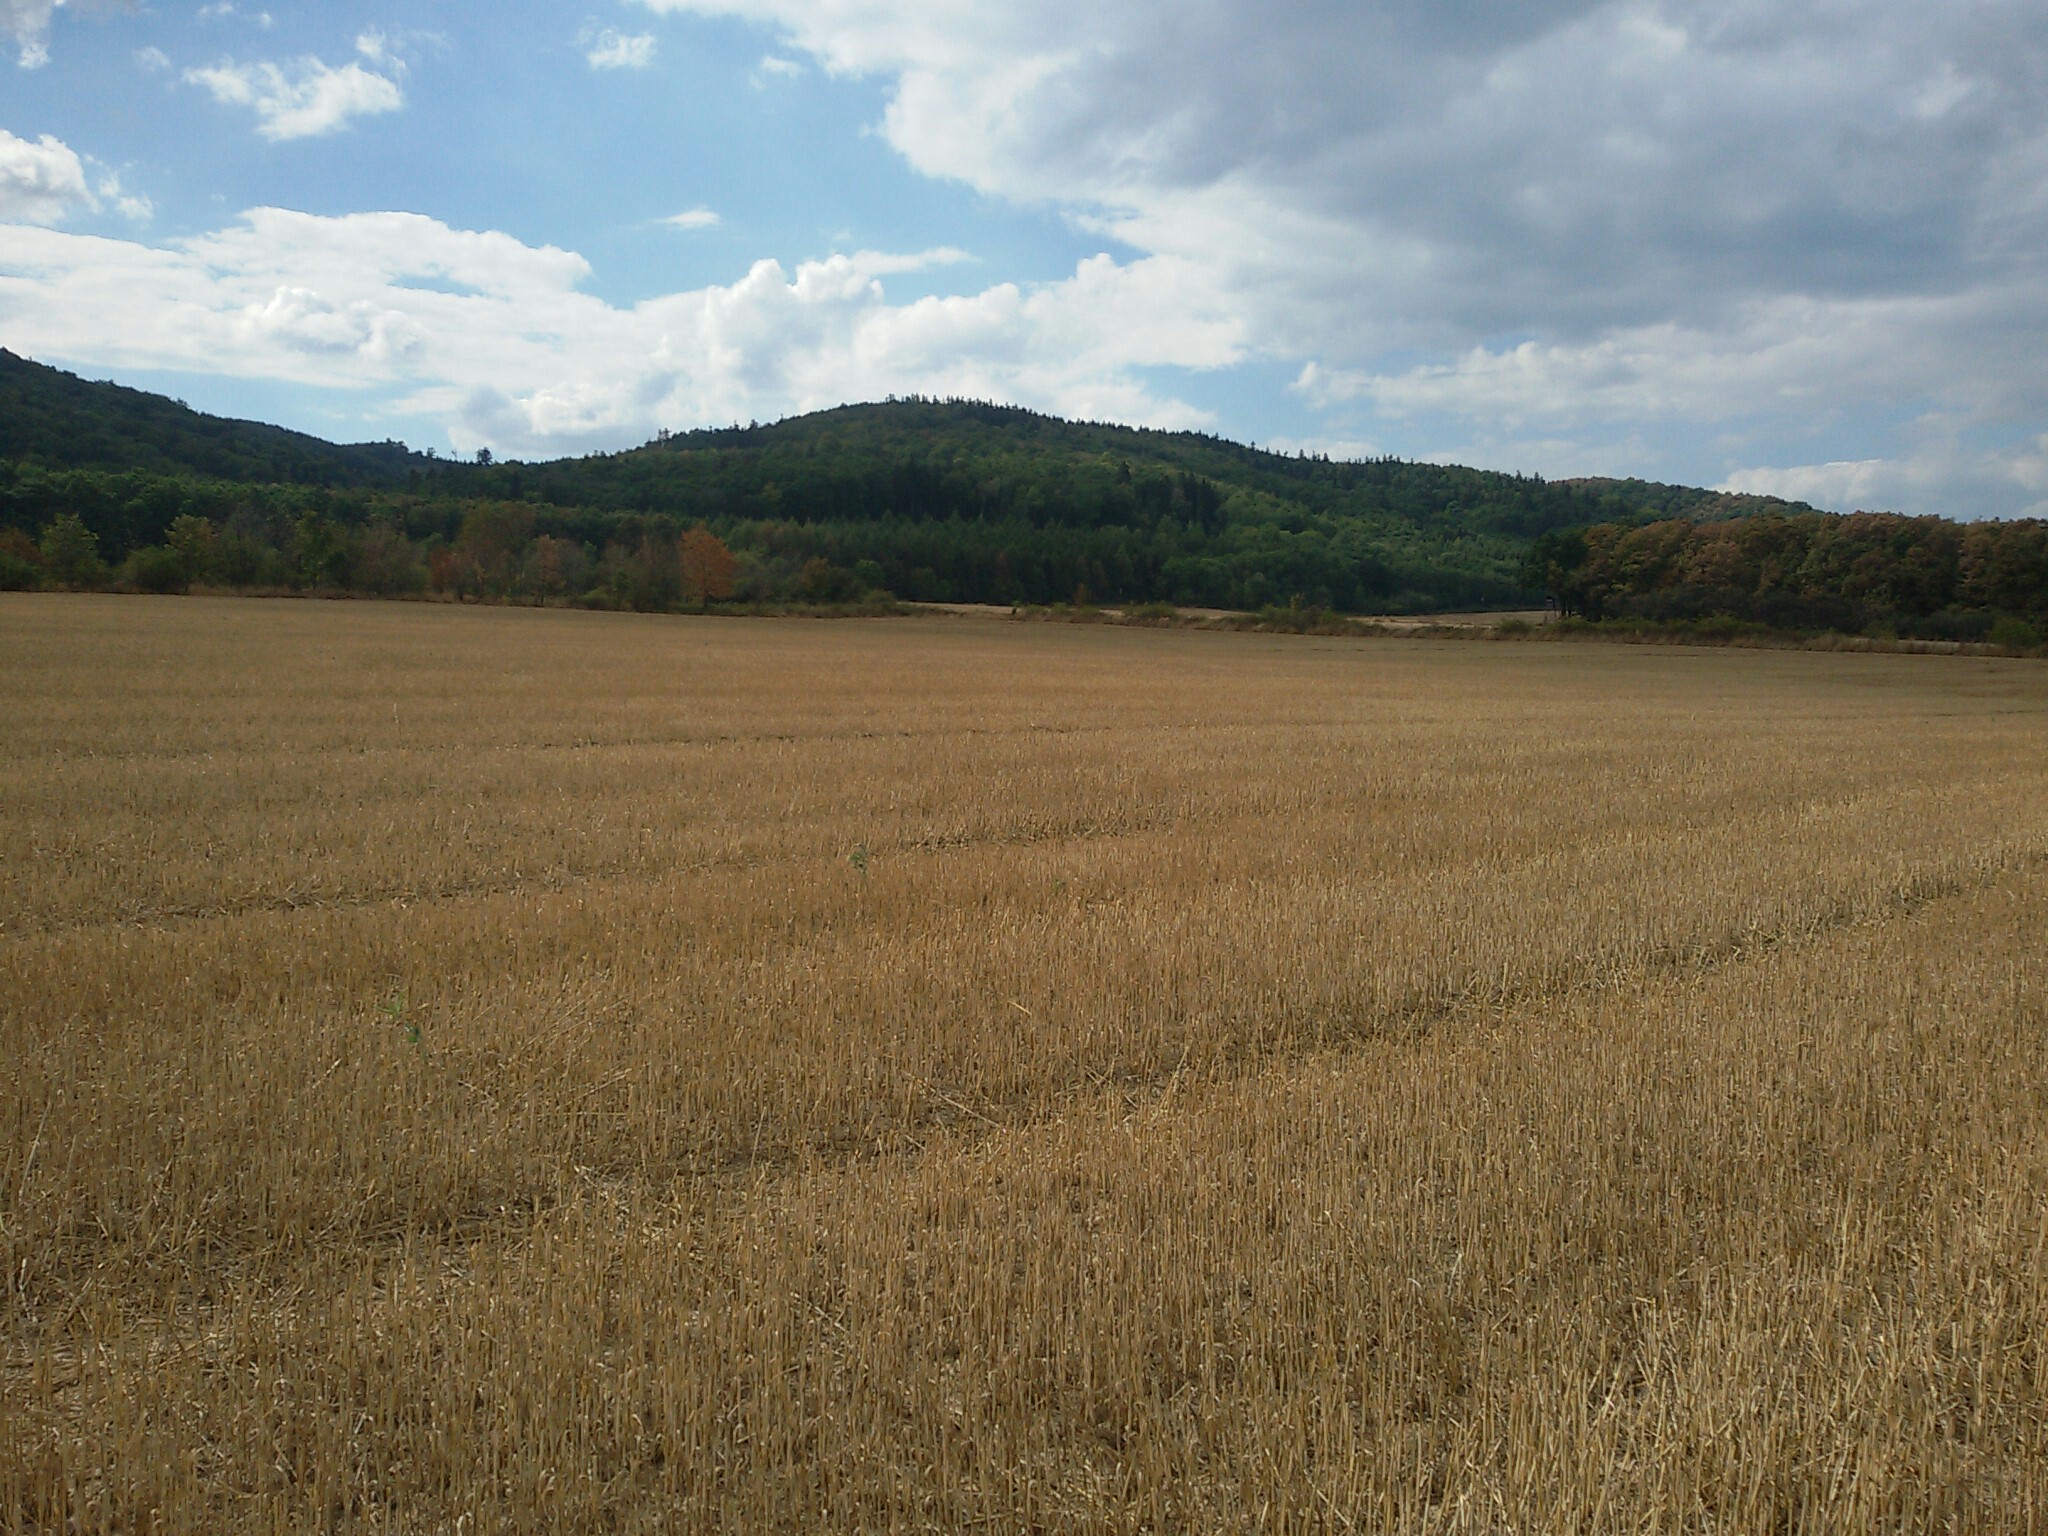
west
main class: Cropland
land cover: Common wheat
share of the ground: > 75 %
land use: Agriculture (excluding fallow land and kitchen gardens)
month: September
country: PL
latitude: 50.5458
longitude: 16.7119
